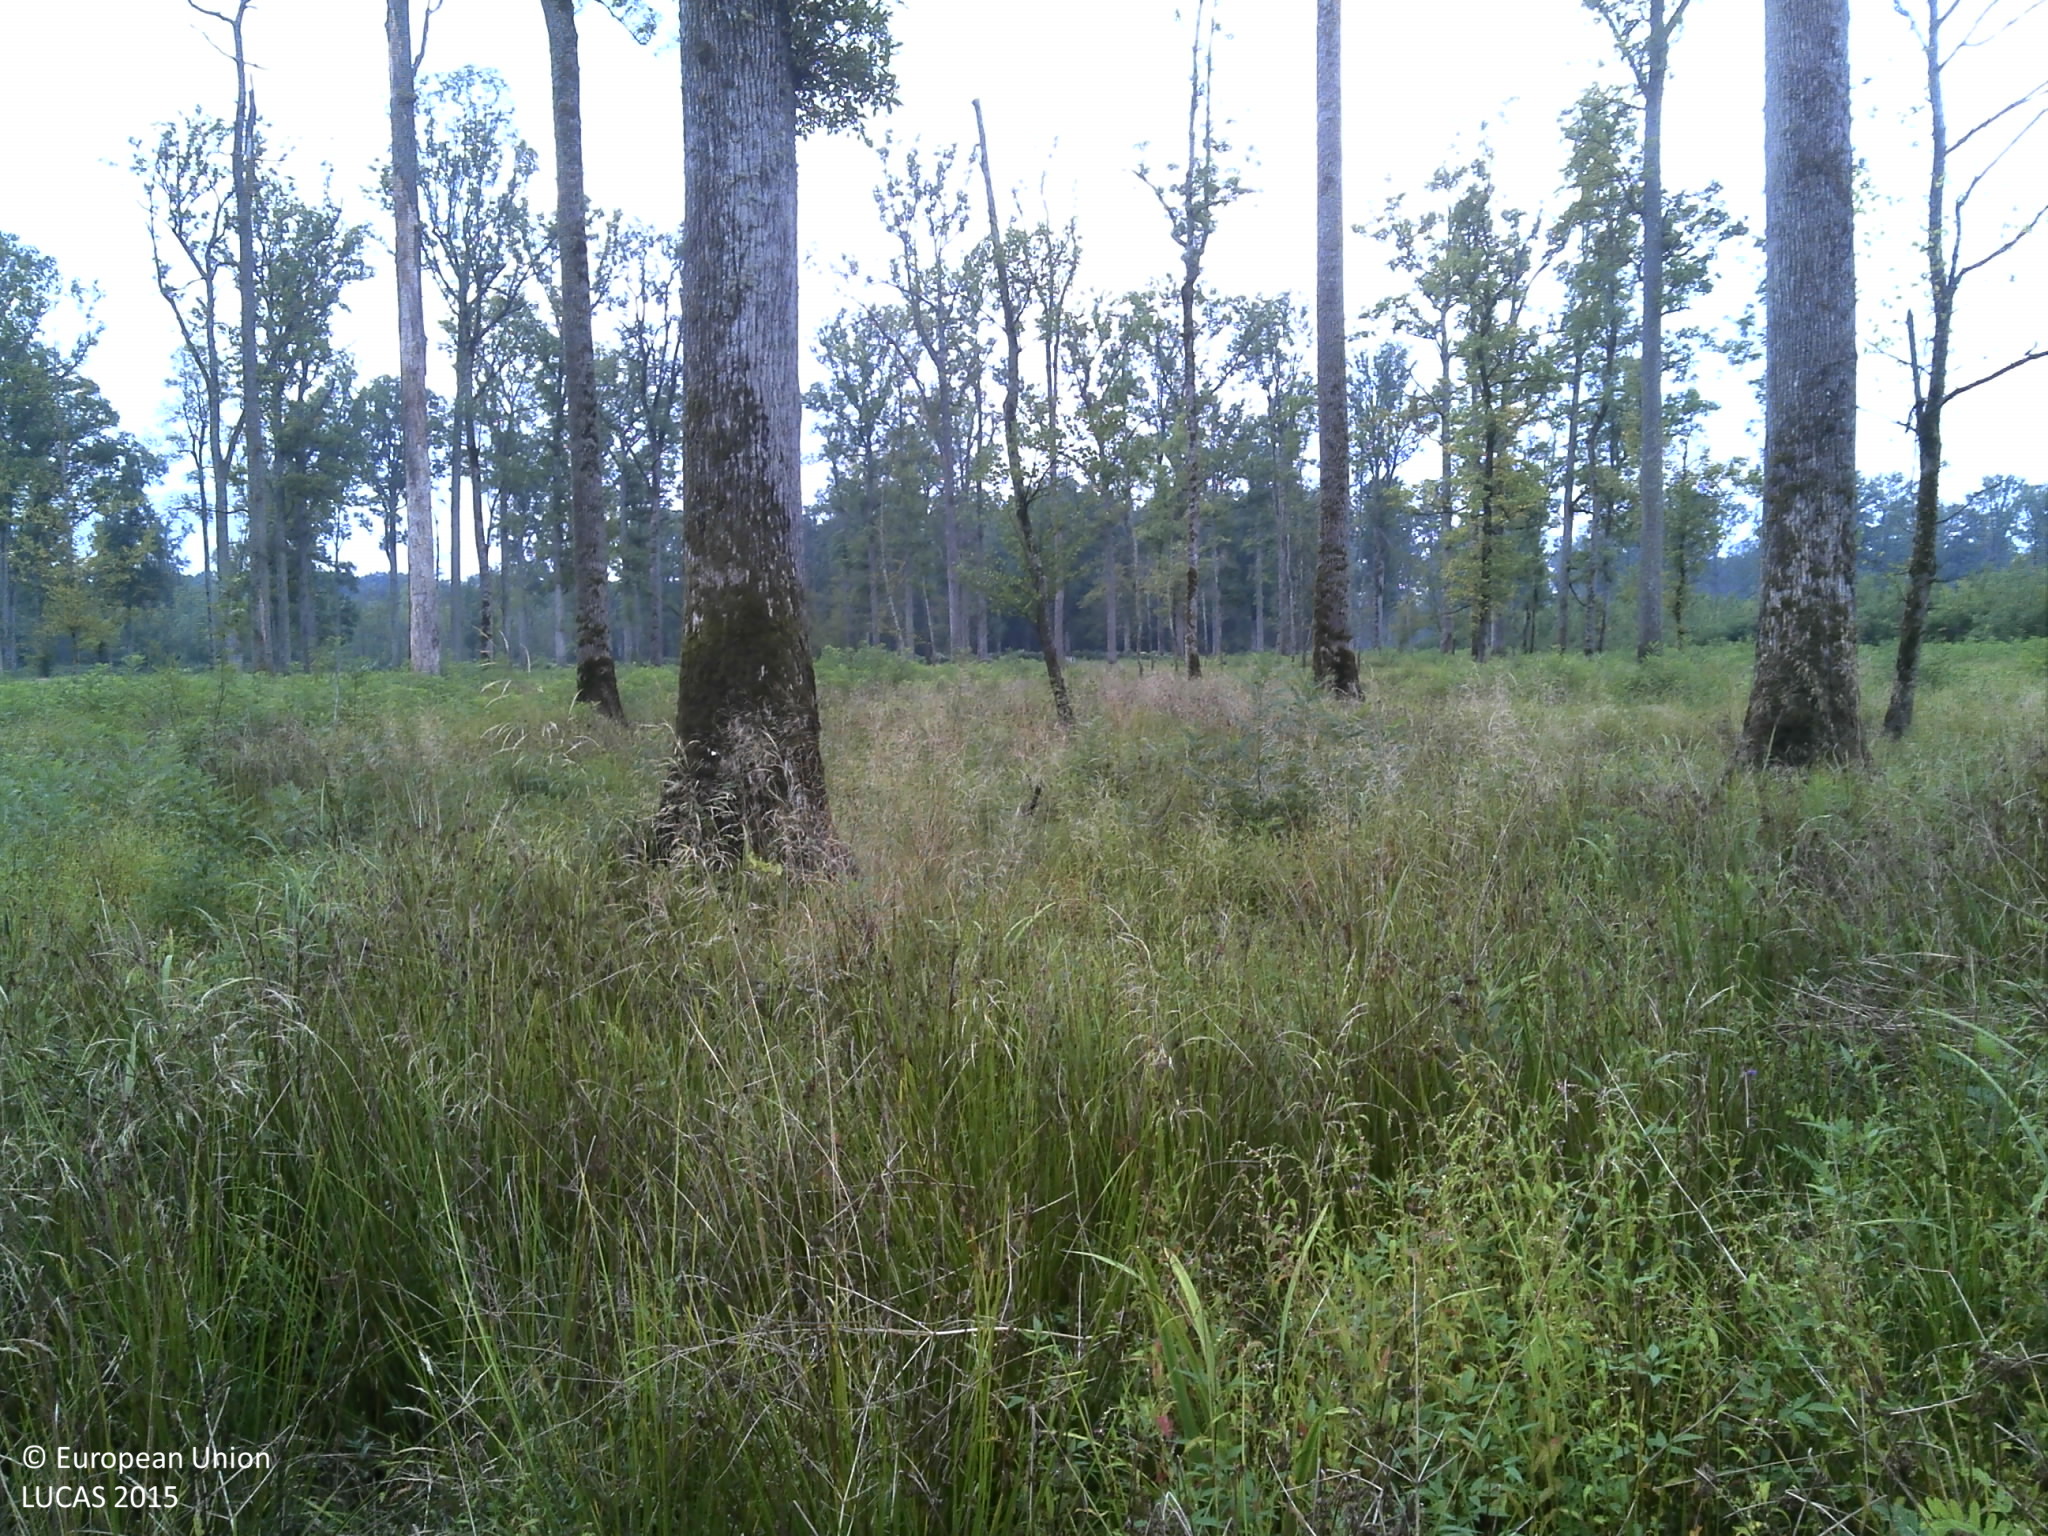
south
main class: Woodland
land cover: Broadleaved woodland
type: acidophilous oak and oak-birch forest
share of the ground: 25 - 50 %
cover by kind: herbaceous plants 60 %, broadleaved forest trees 40 %
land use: Forestry
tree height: > 5 m
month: August
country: HR
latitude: 45.2887
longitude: 16.7429
